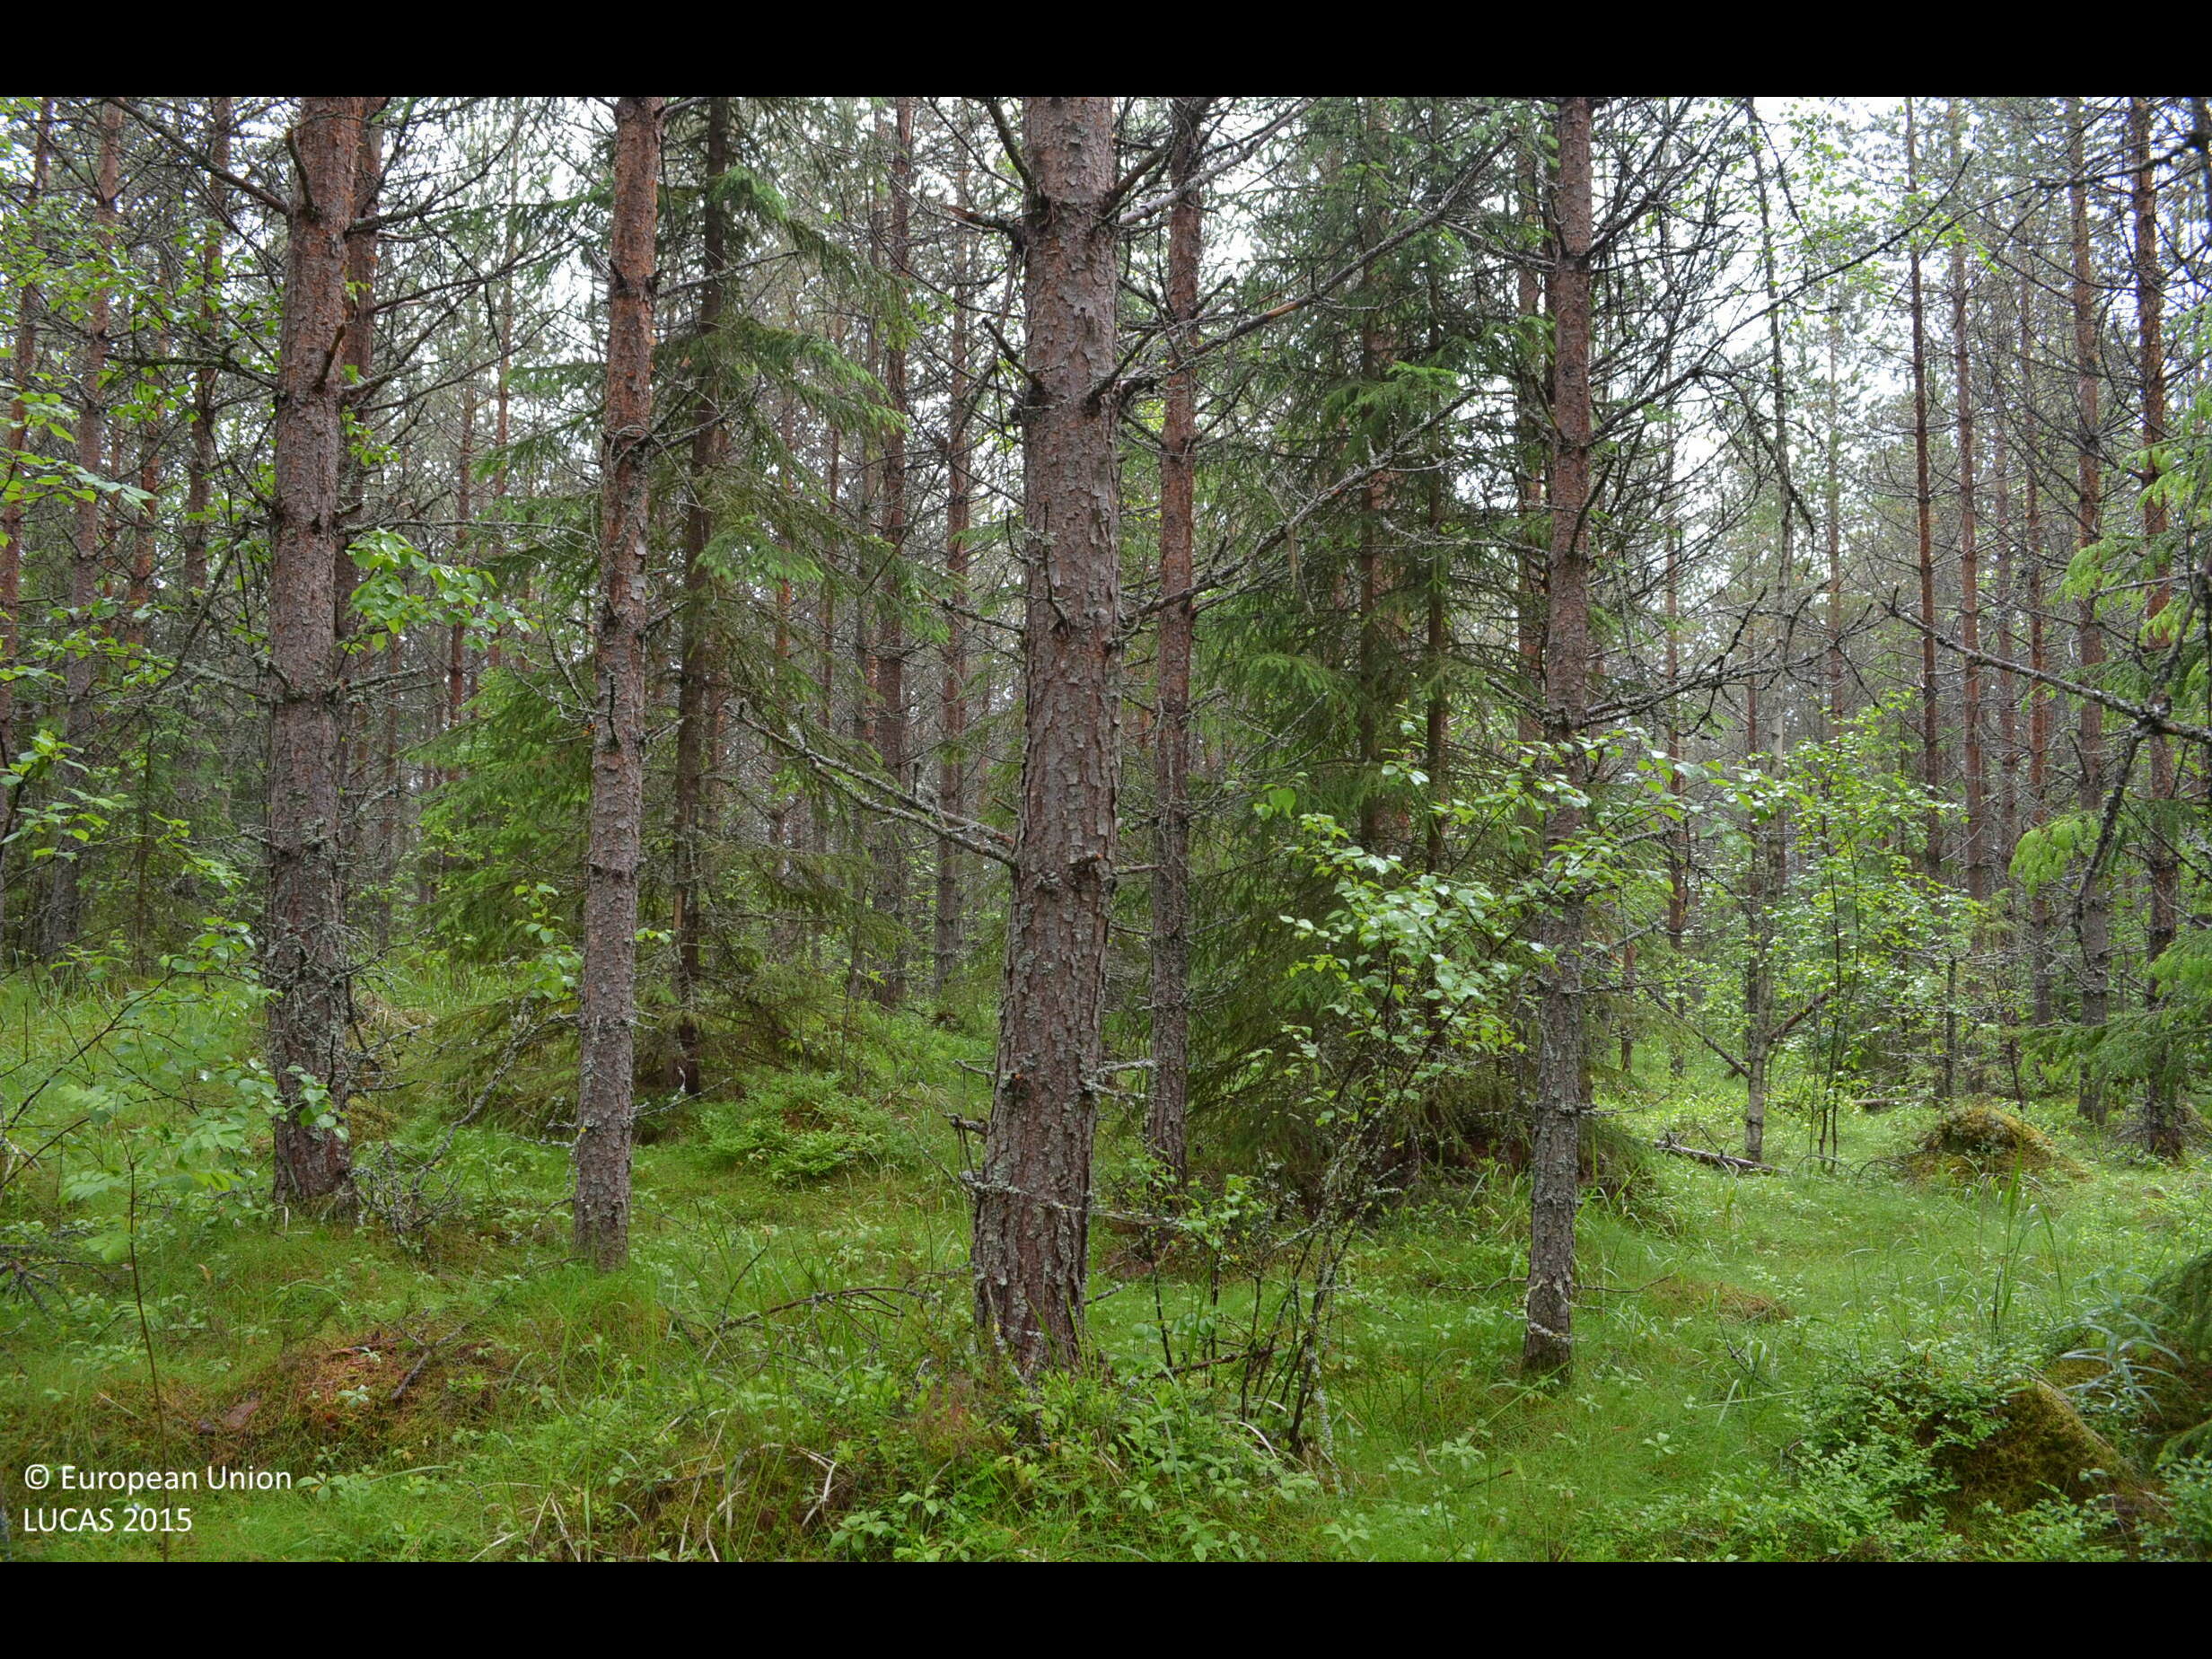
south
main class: Woodland
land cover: Pine dominated coniferous woodland
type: boreal forest
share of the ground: > 75 %
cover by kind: coniferous forest trees 80 %, broadleaved forest trees 10 %, shrubs 5 %, herbaceous plants 5 %
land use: Forestry
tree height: > 5 m
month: June
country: FI
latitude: 61.9974
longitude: 23.5360
